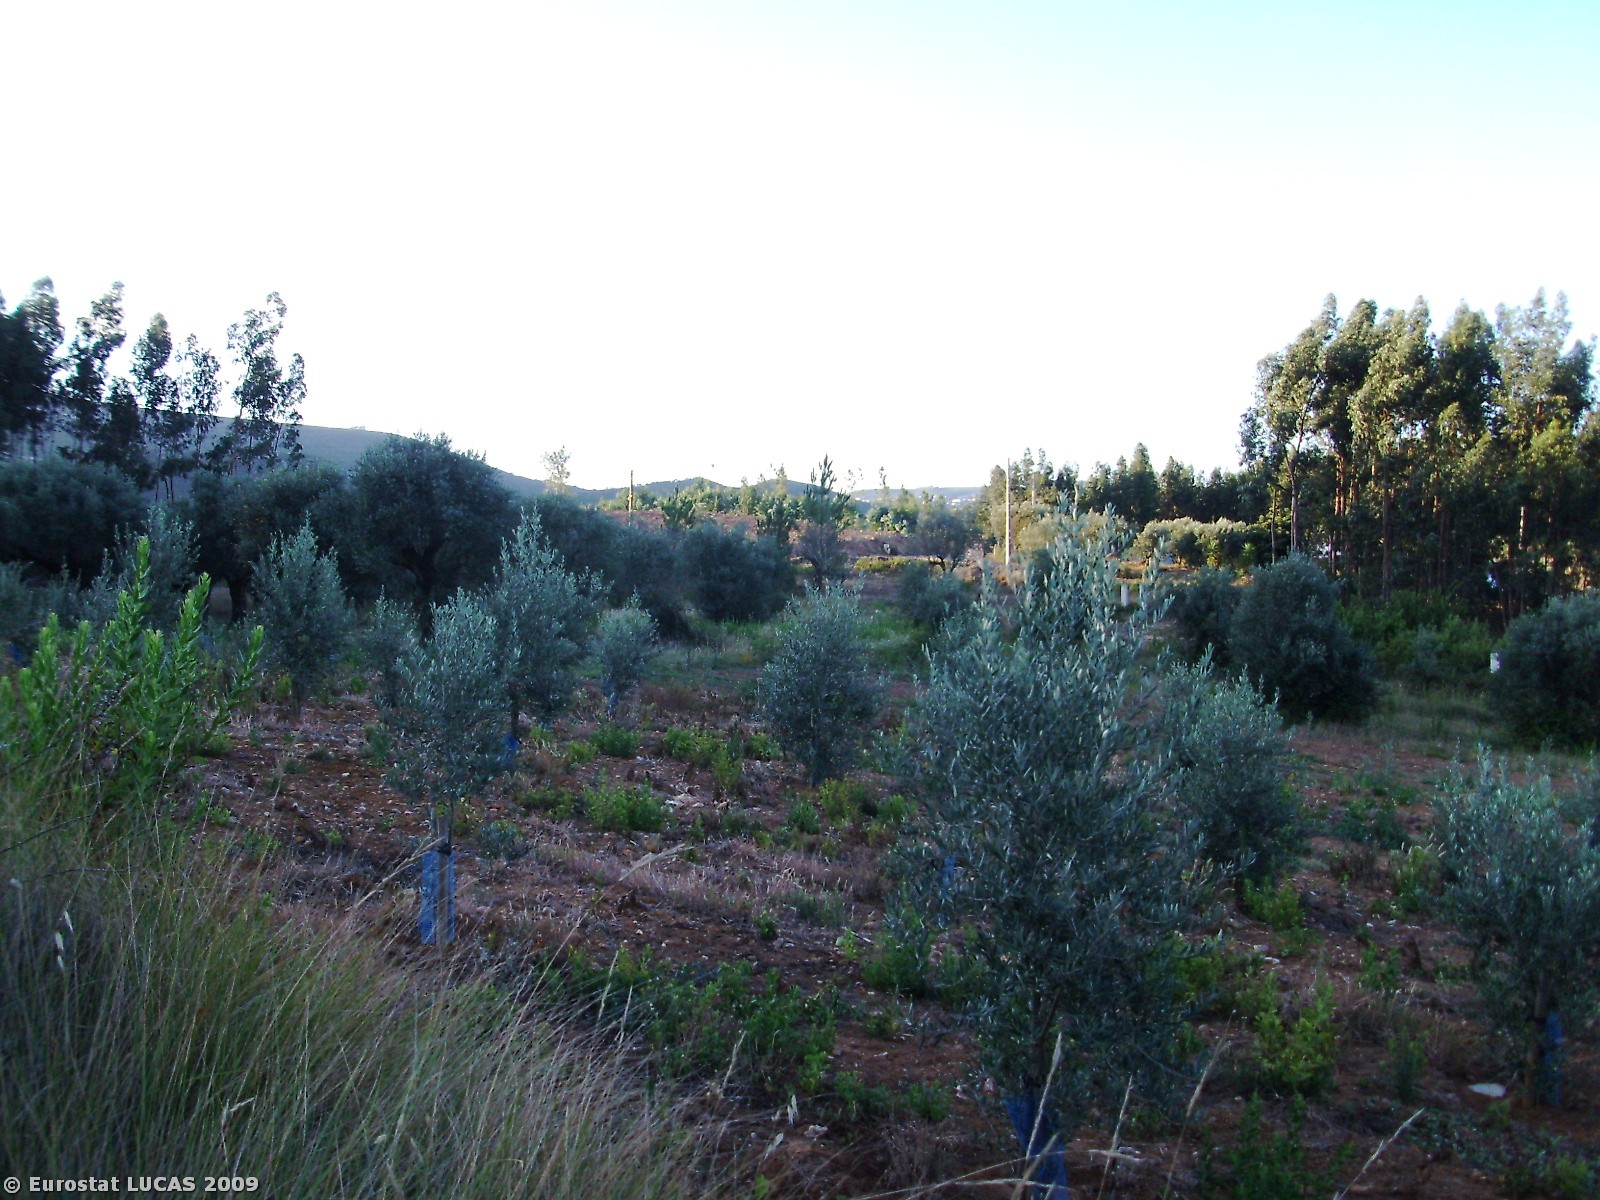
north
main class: Shrubland
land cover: Shrubland with sparse tree cover
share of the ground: > 75 %
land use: Fallow land
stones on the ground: 10 - 25 %
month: July
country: PT
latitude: 39.4098
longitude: -8.9086
